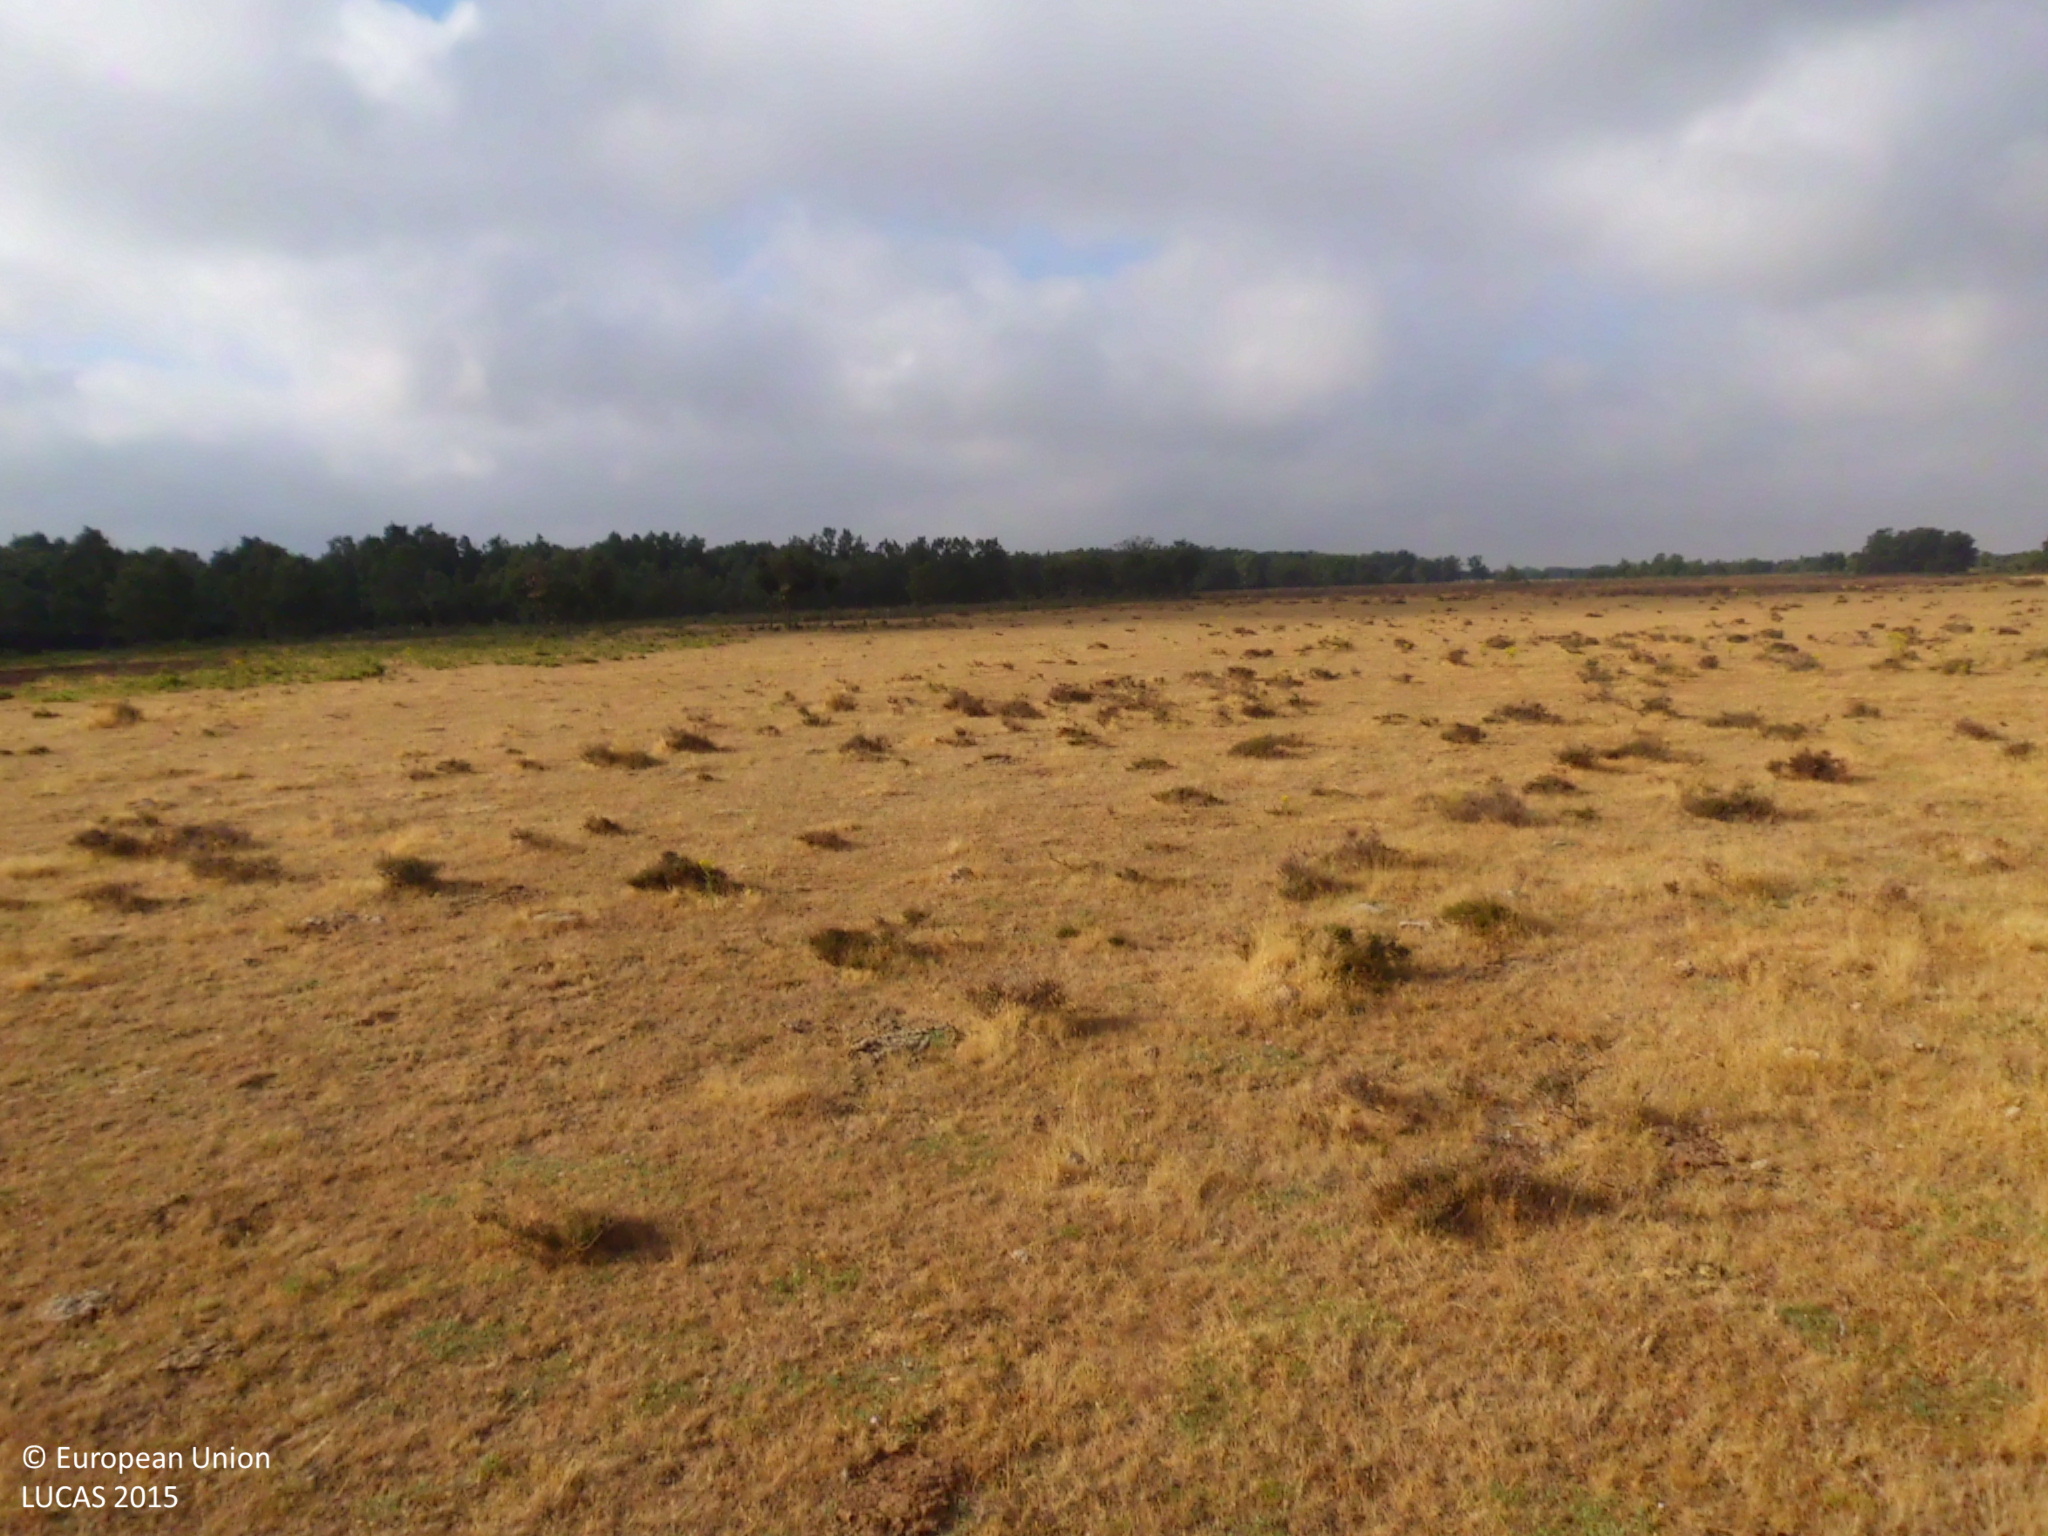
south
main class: Grassland
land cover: Grassland without tree/shrub cover
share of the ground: > 75 %
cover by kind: herbaceous plants 90 %, unconsolidated bare surface 10 %
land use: Agriculture (excluding fallow land and kitchen gardens)
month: July
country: ES
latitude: 42.5700
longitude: -4.9093
